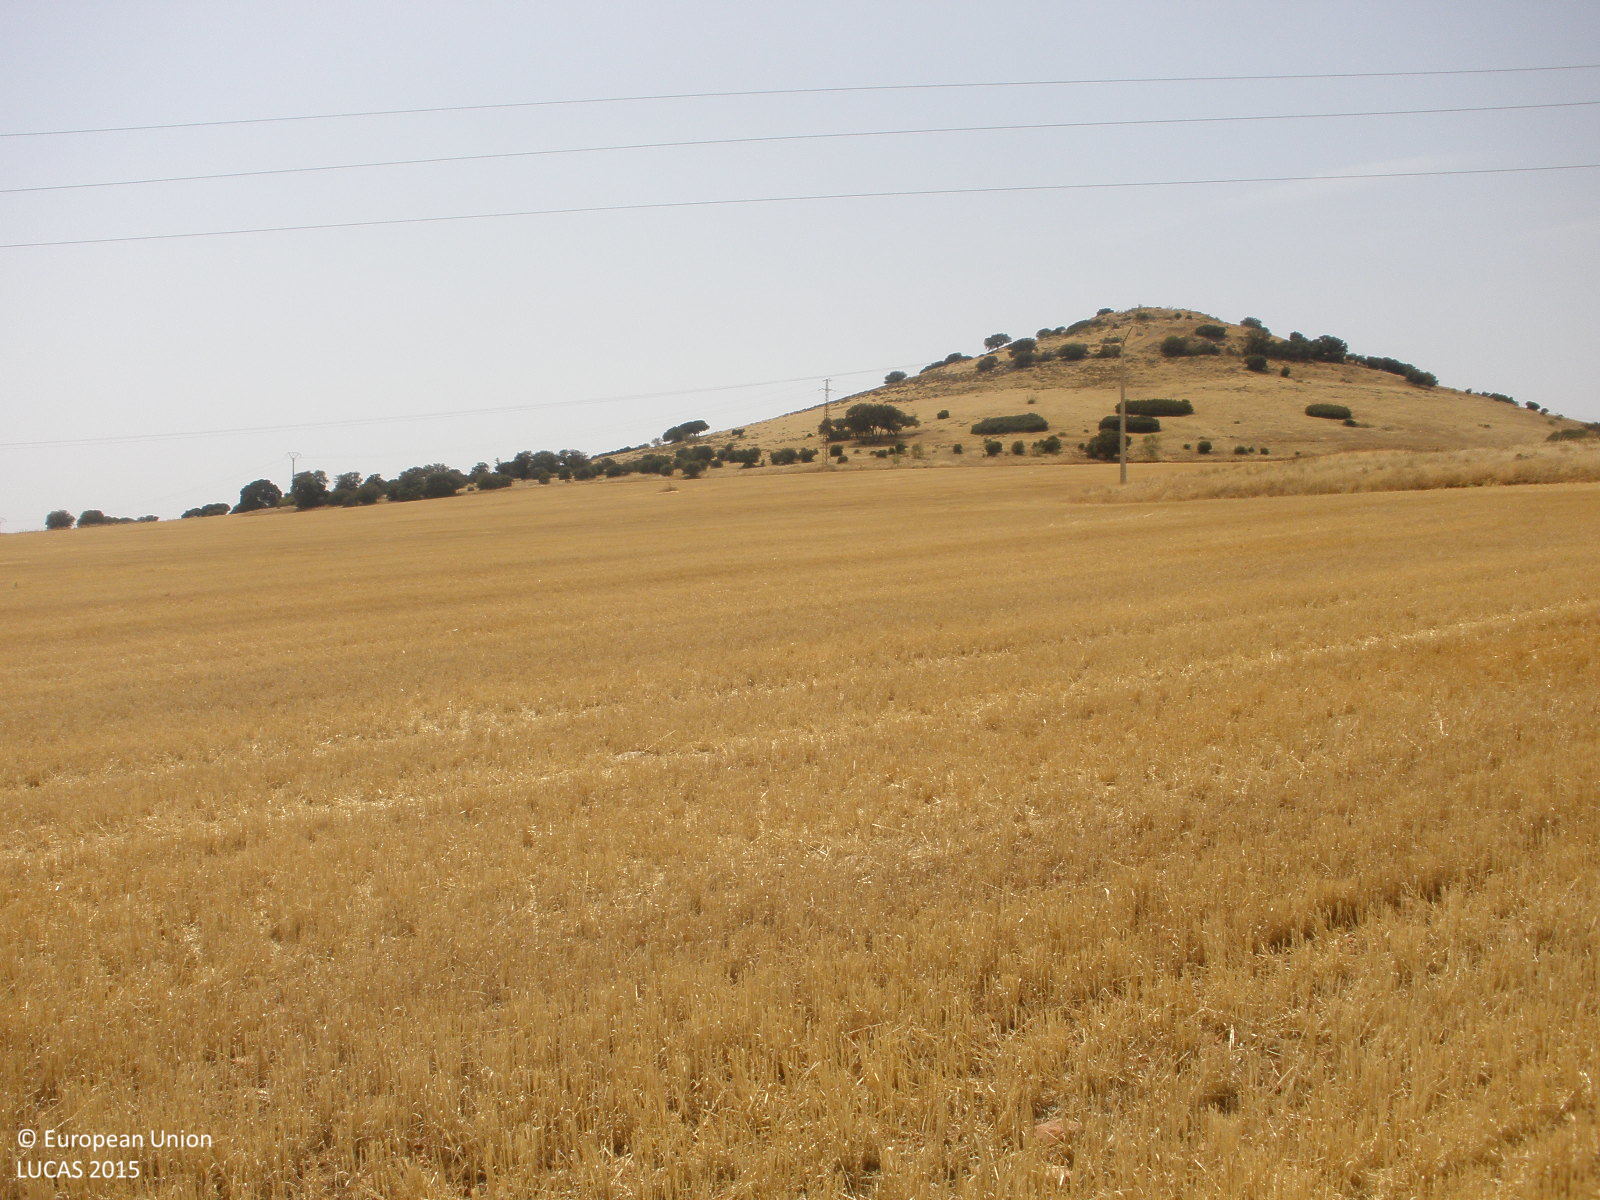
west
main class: Cropland
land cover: Common wheat
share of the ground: < 10 %
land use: Agriculture (excluding fallow land and kitchen gardens)
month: July
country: ES
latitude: 39.7378
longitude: -3.1964
